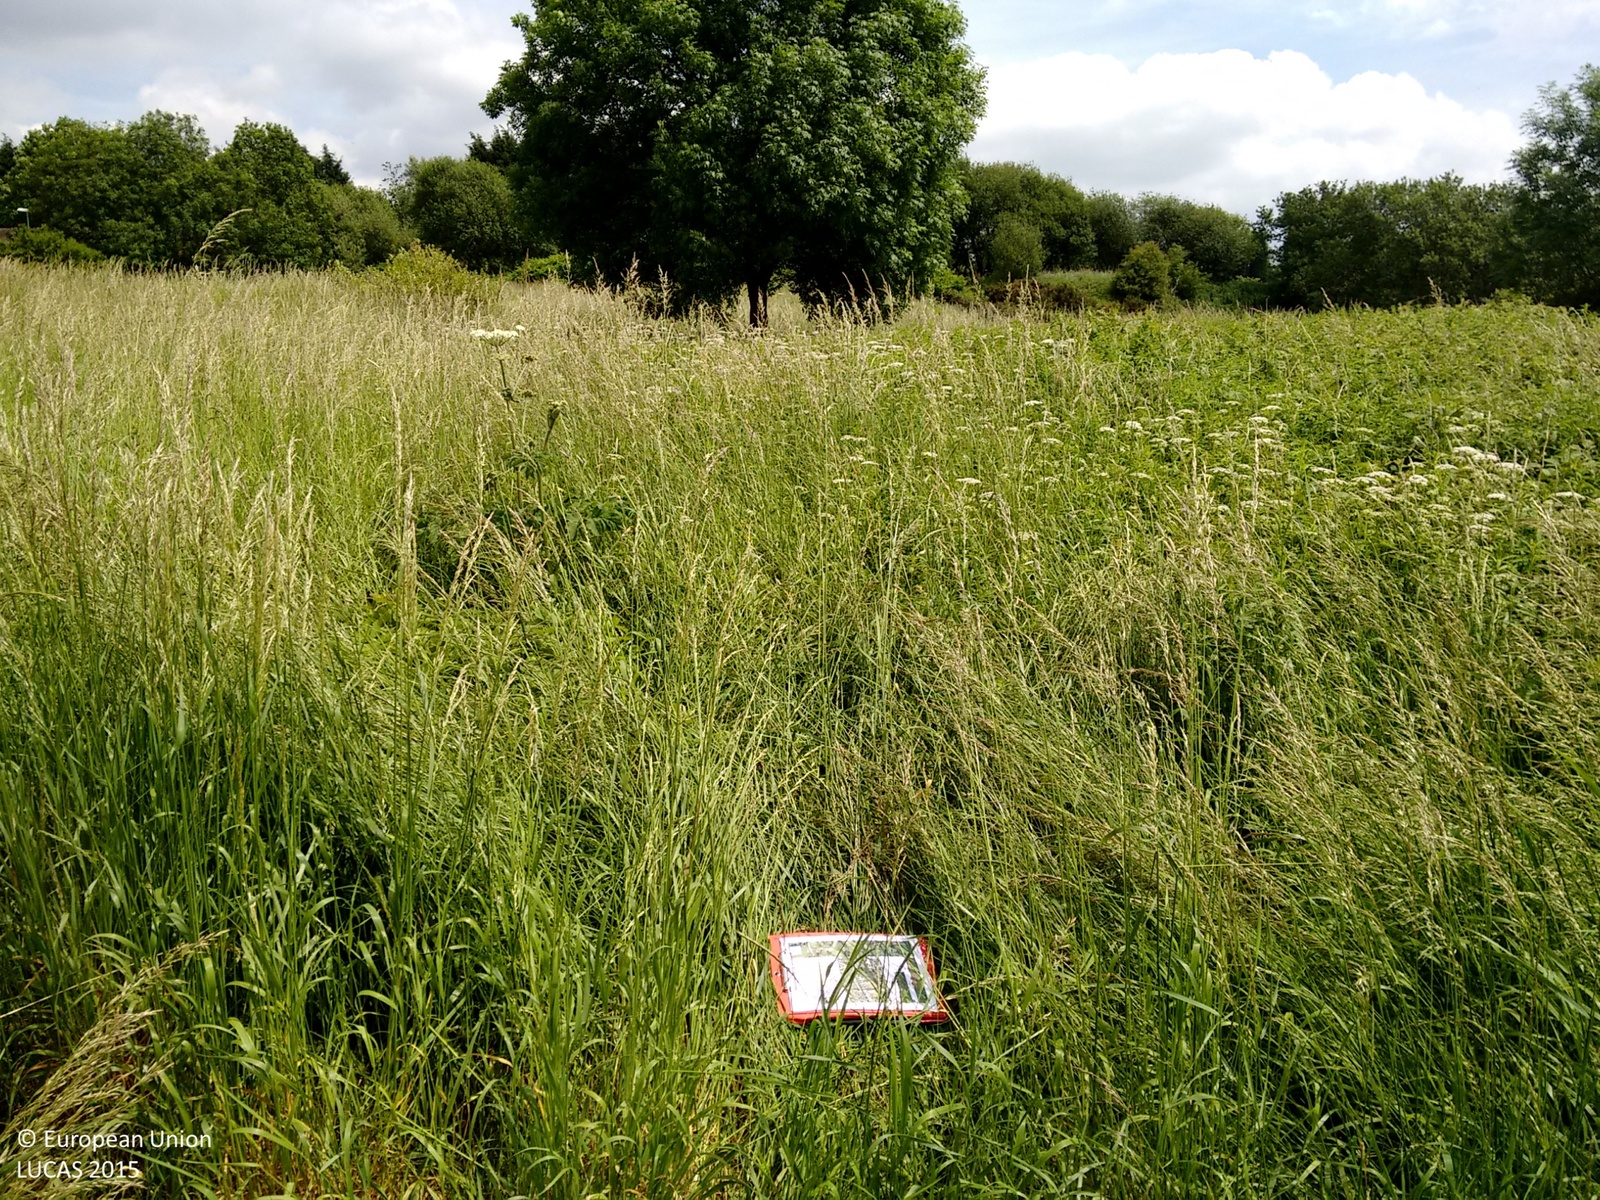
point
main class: Grassland
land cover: Grassland with sparse tree/shrub cover
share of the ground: > 75 %
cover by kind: herbaceous plants 95 %, broadleaved forest trees 5 %
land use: Semi-natural and natural areas not in use
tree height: < 5 m
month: June
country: GB
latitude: 53.4690
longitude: -2.0649
